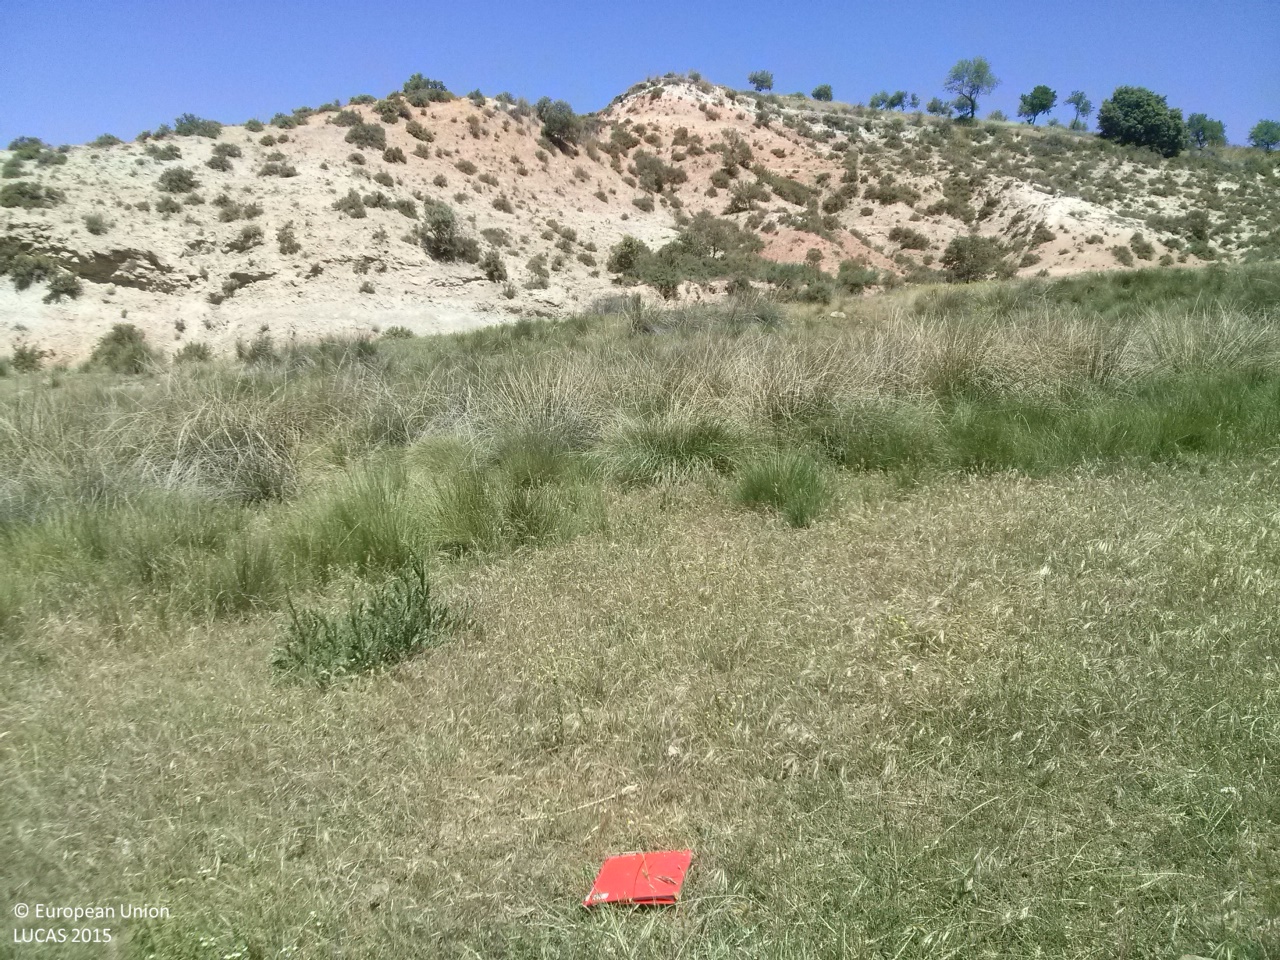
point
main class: Grassland
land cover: Grassland without tree/shrub cover
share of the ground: > 75 %
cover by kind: herbaceous plants 100 %
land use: Abandoned areas
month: May
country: ES
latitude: 40.3998
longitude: -2.6196
